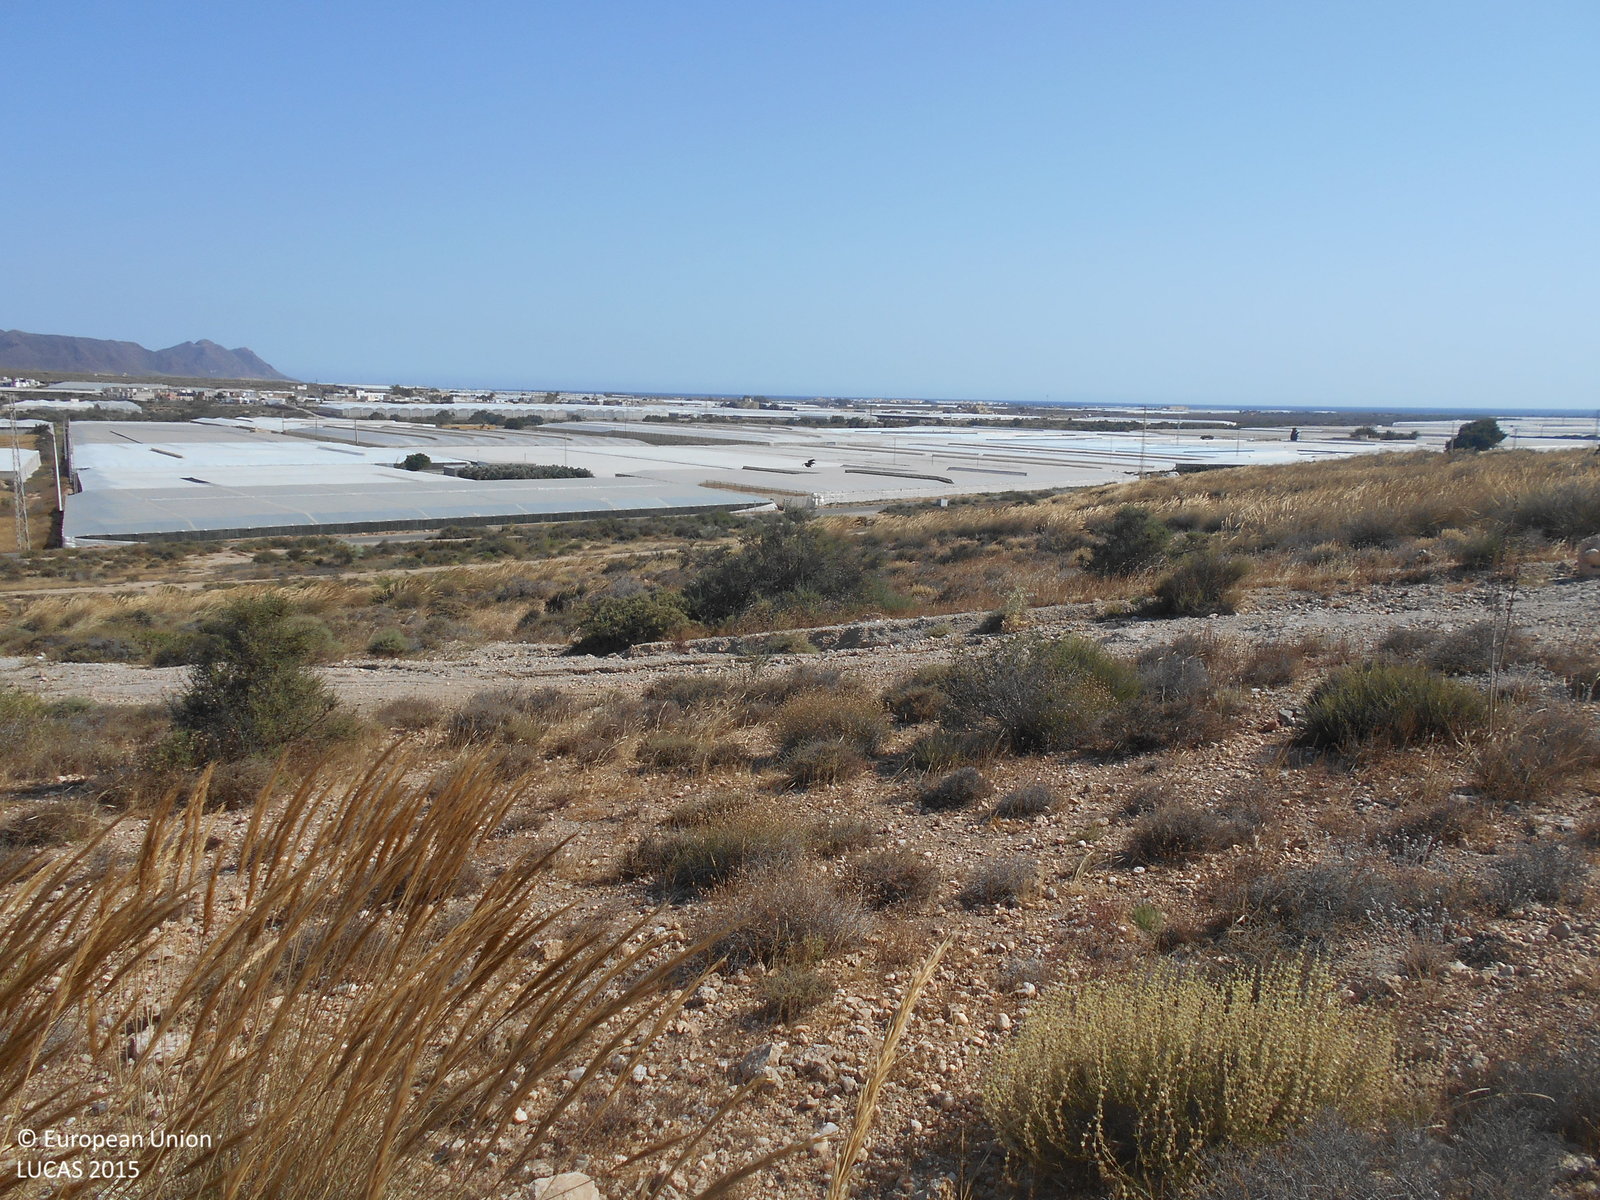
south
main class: Shrubland
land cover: Shrubland without tree cover
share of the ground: 25 - 50 %
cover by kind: shrubs 40 %, unconsolidated bare surface 30 %, consolidated bare surface 20 %, herbaceous plants 10 %
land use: Semi-natural and natural areas not in use
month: May
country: ES
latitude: 36.8269
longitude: -2.2279
